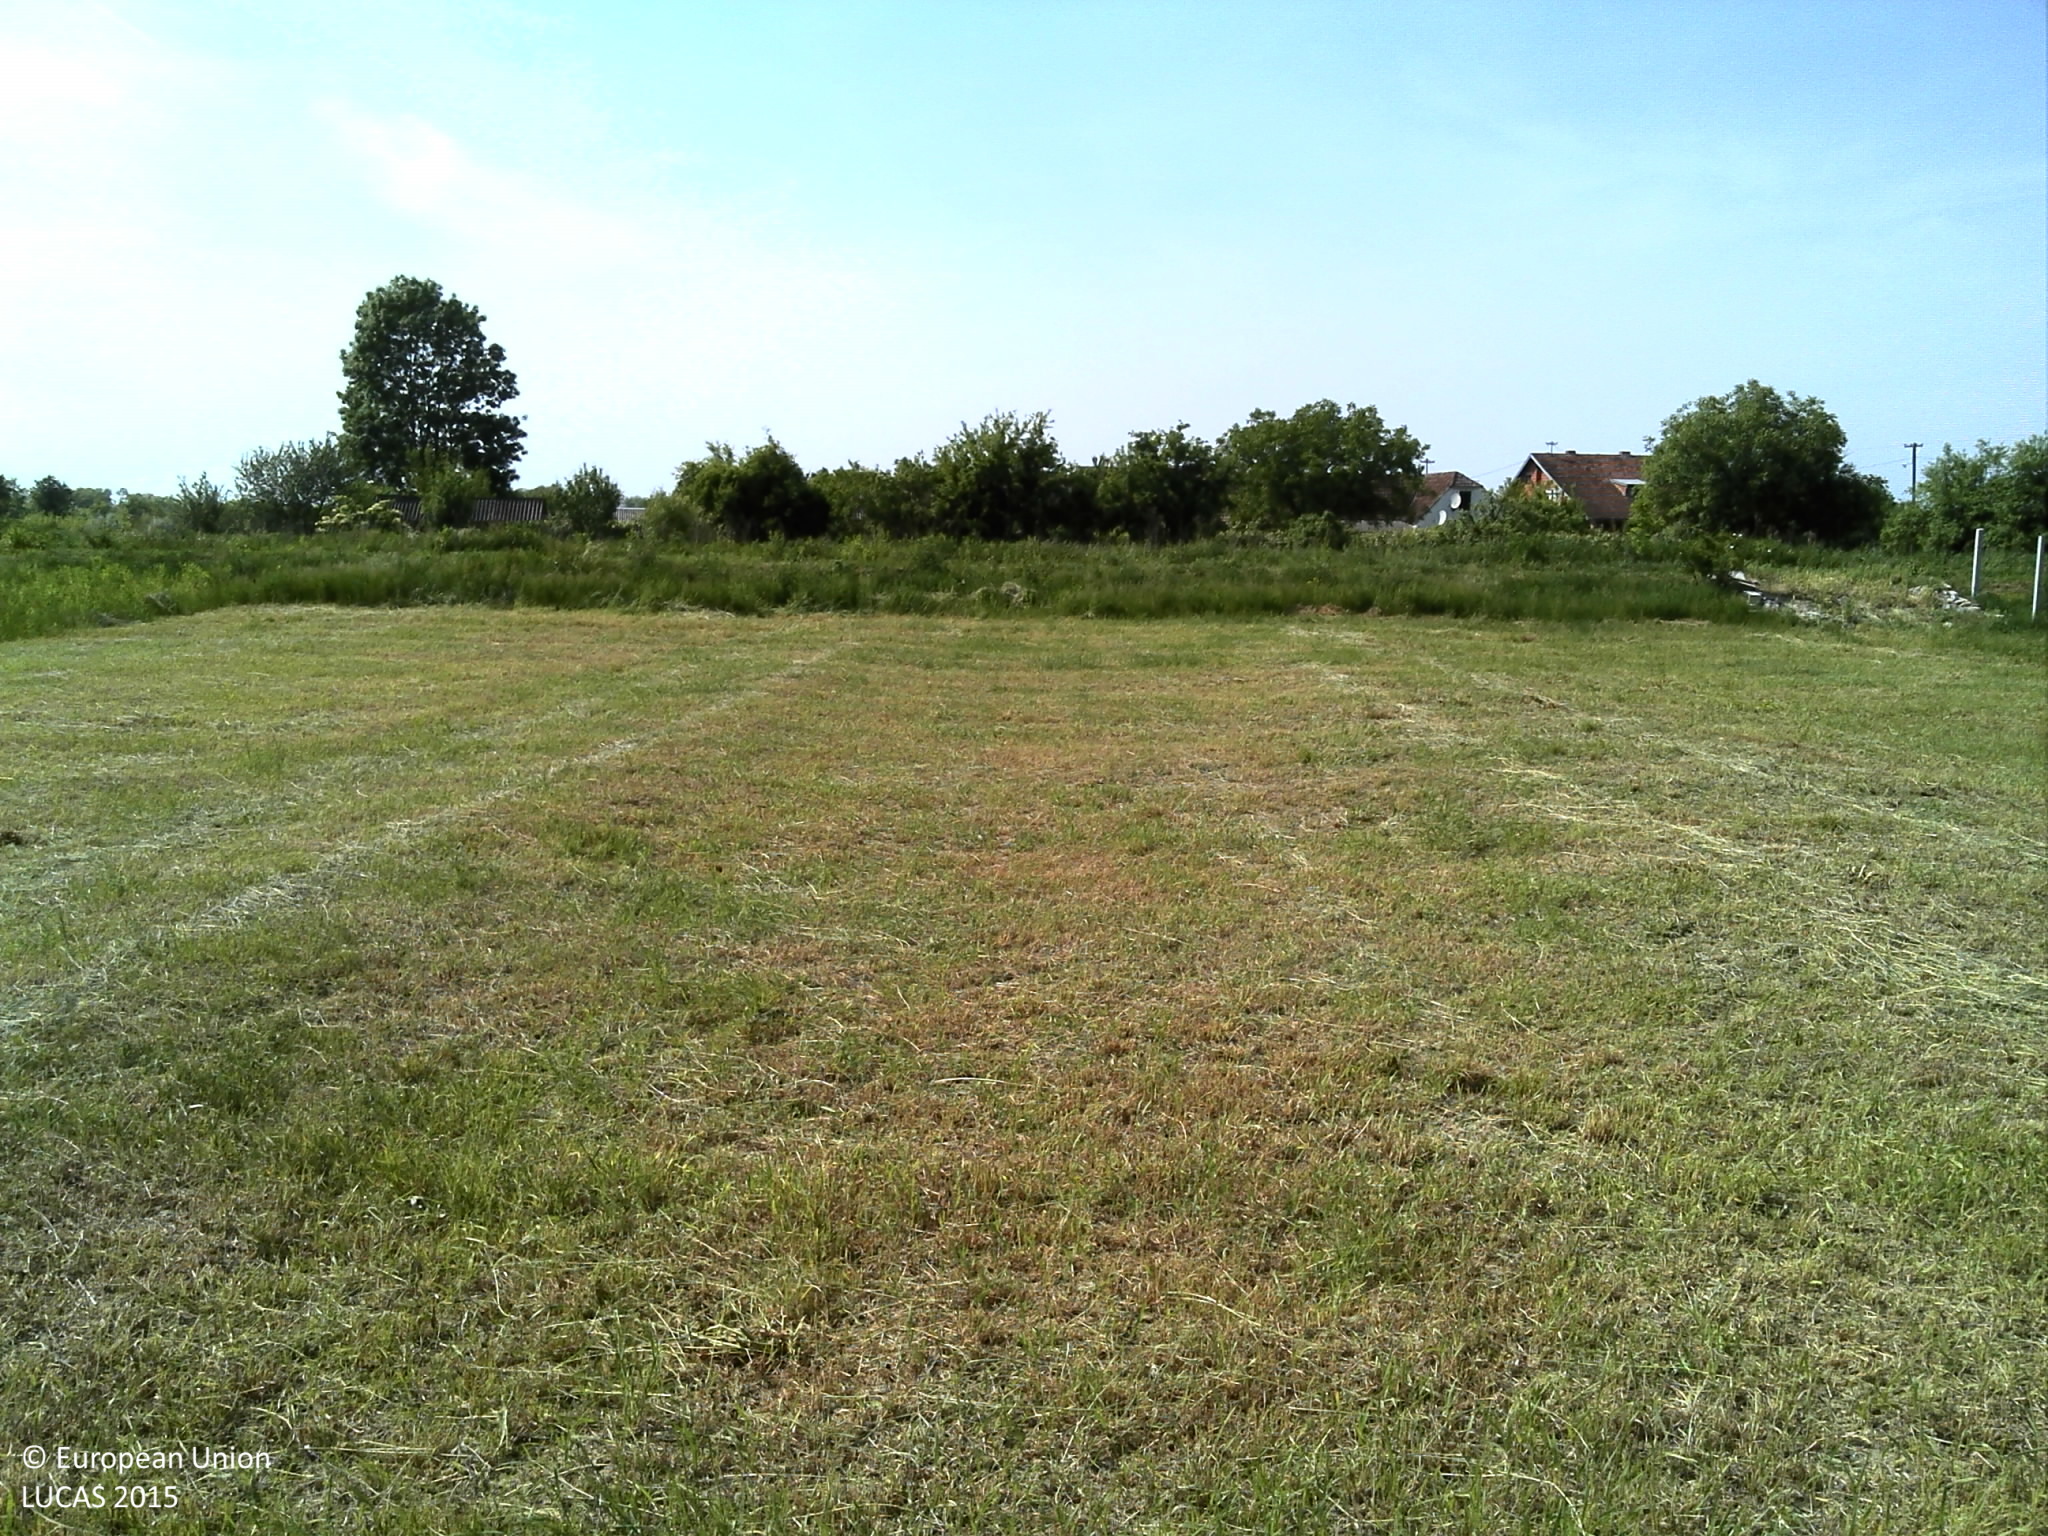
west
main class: Cropland
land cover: Temporary grasslands
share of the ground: > 75 %
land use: Agriculture (excluding fallow land and kitchen gardens)
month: May
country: HR
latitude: 45.5598
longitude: 18.0368
